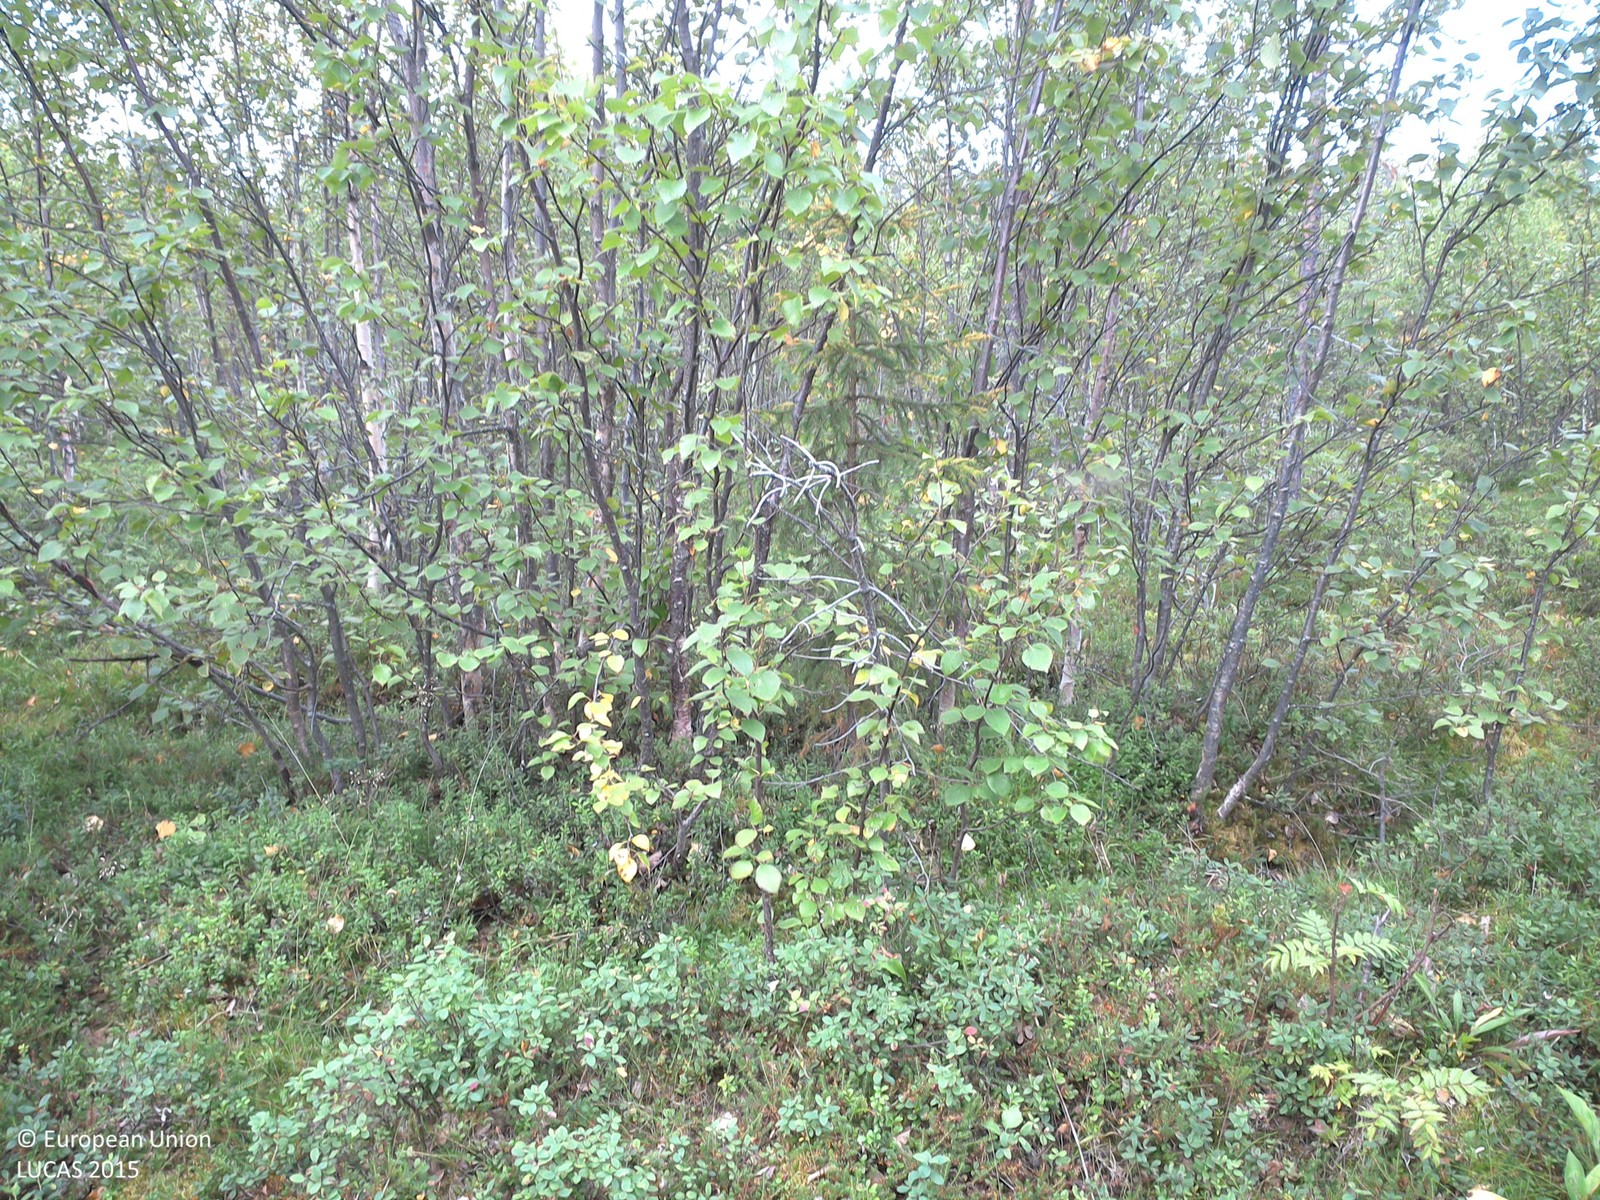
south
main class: Woodland
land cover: Other mixed woodland
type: boreal forest
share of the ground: 25 - 50 %
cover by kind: shrubs 65 %, broadleaved forest trees 20 %, coniferous forest trees 10 %, lichens and mosses 5 %
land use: Forestry
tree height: > 5 m
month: August
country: SE
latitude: 67.3410
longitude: 22.1689
